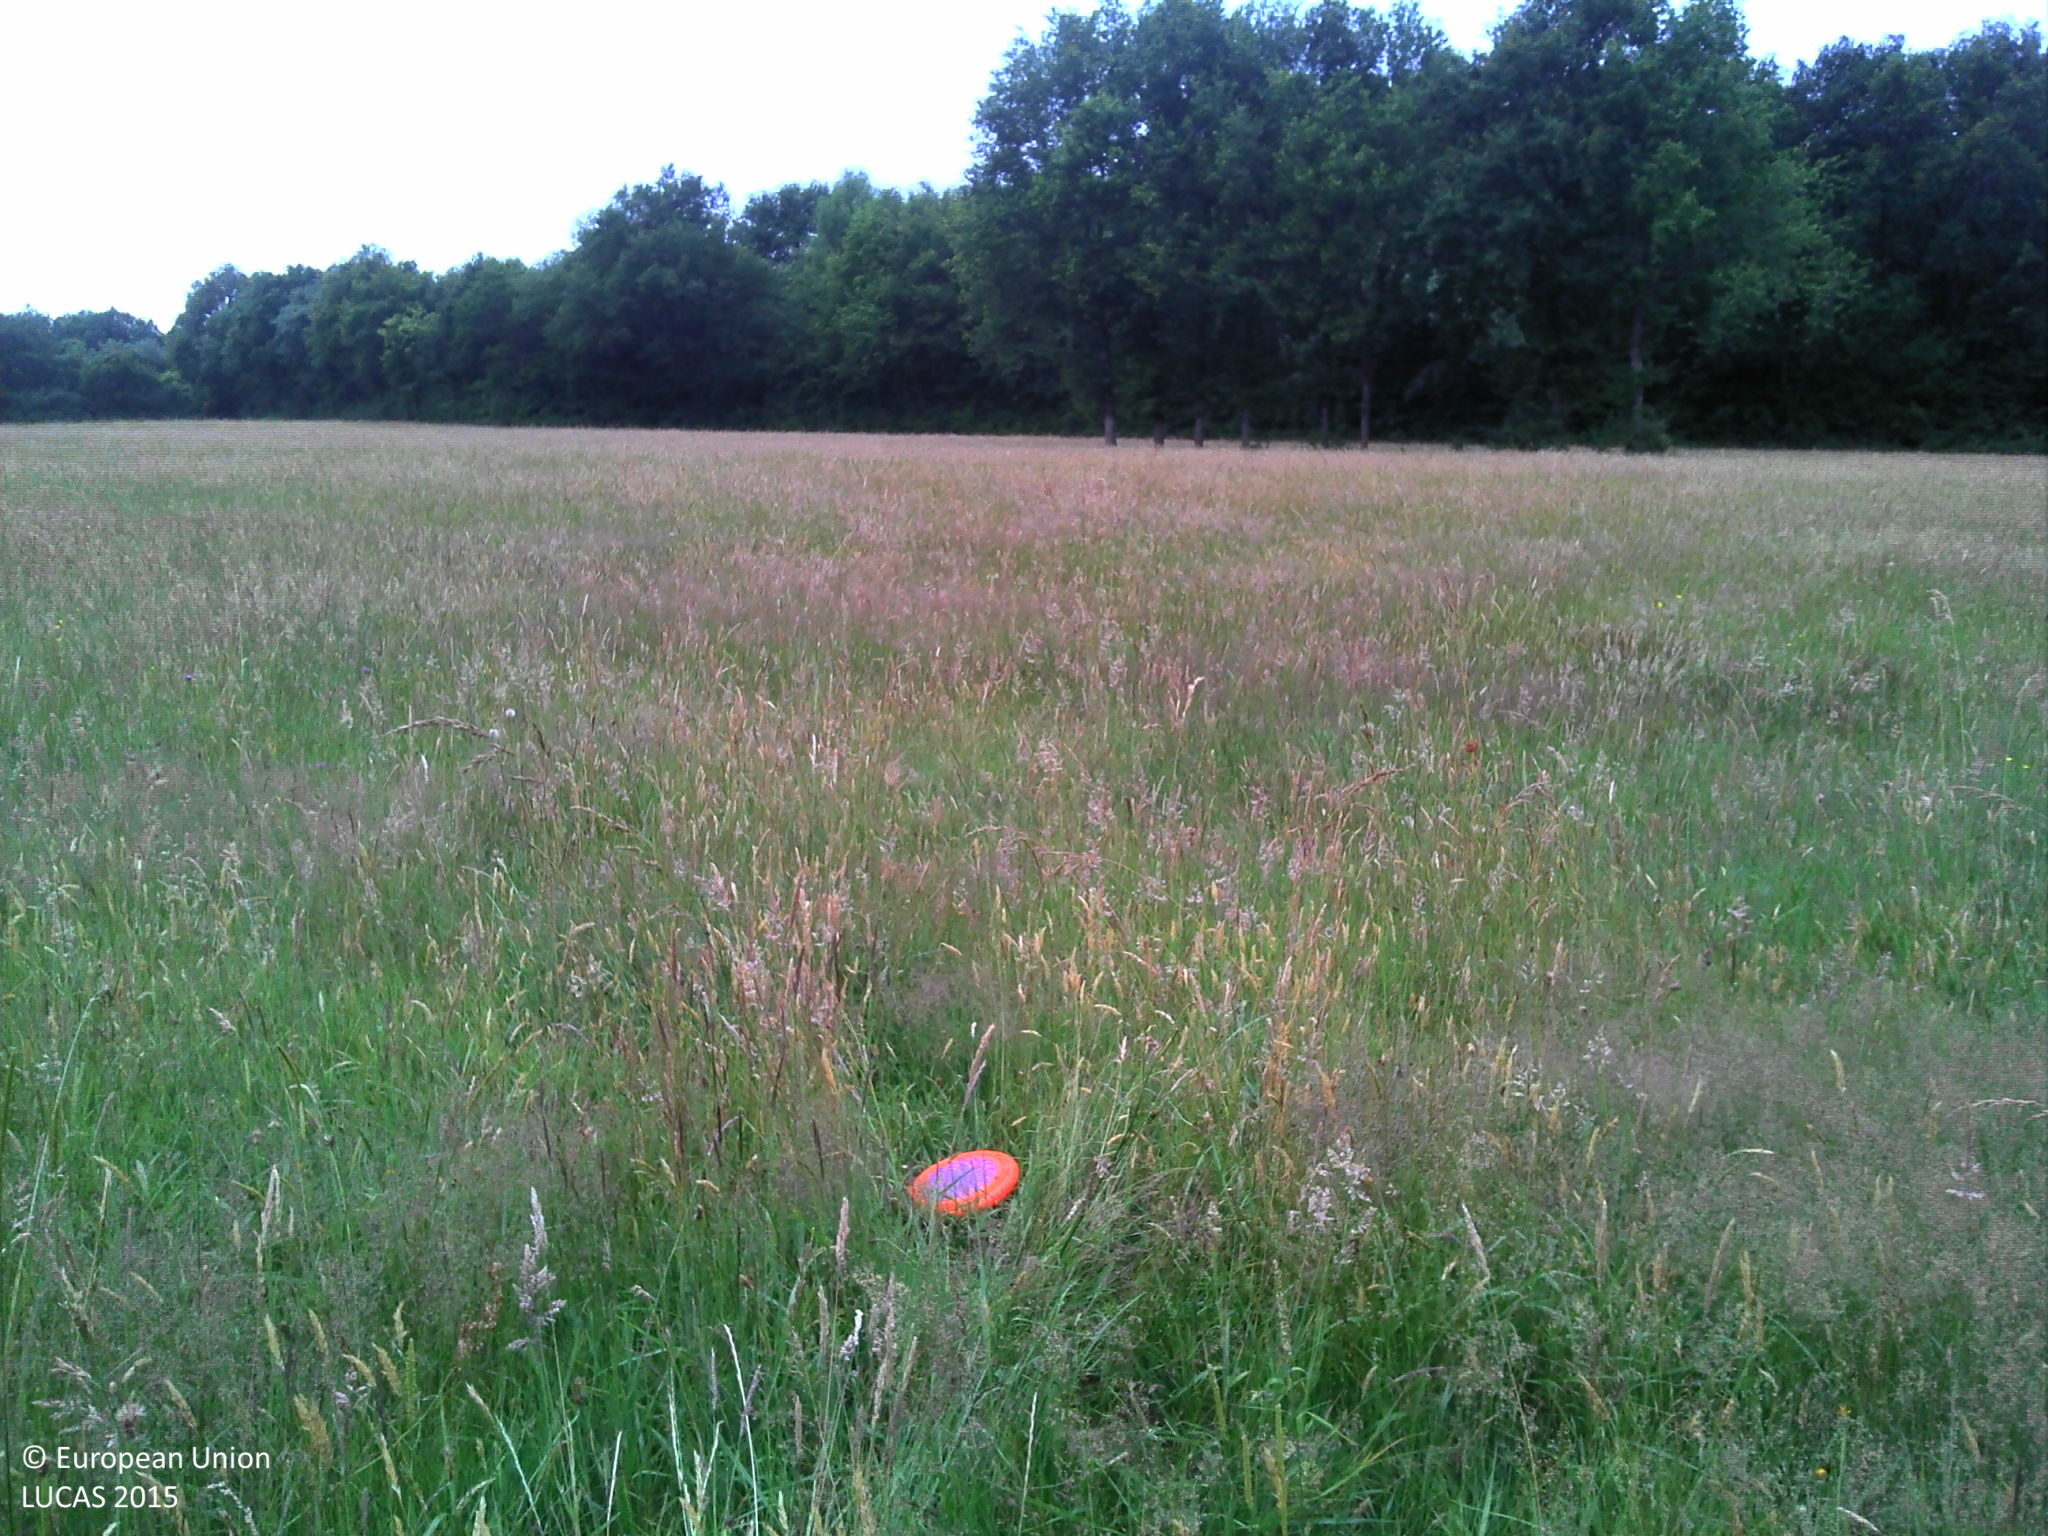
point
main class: Grassland
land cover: Grassland without tree/shrub cover
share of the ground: > 75 %
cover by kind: herbaceous plants 100 %
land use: Agriculture (excluding fallow land and kitchen gardens)
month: June
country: FR
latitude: 47.6460
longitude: 0.0565
